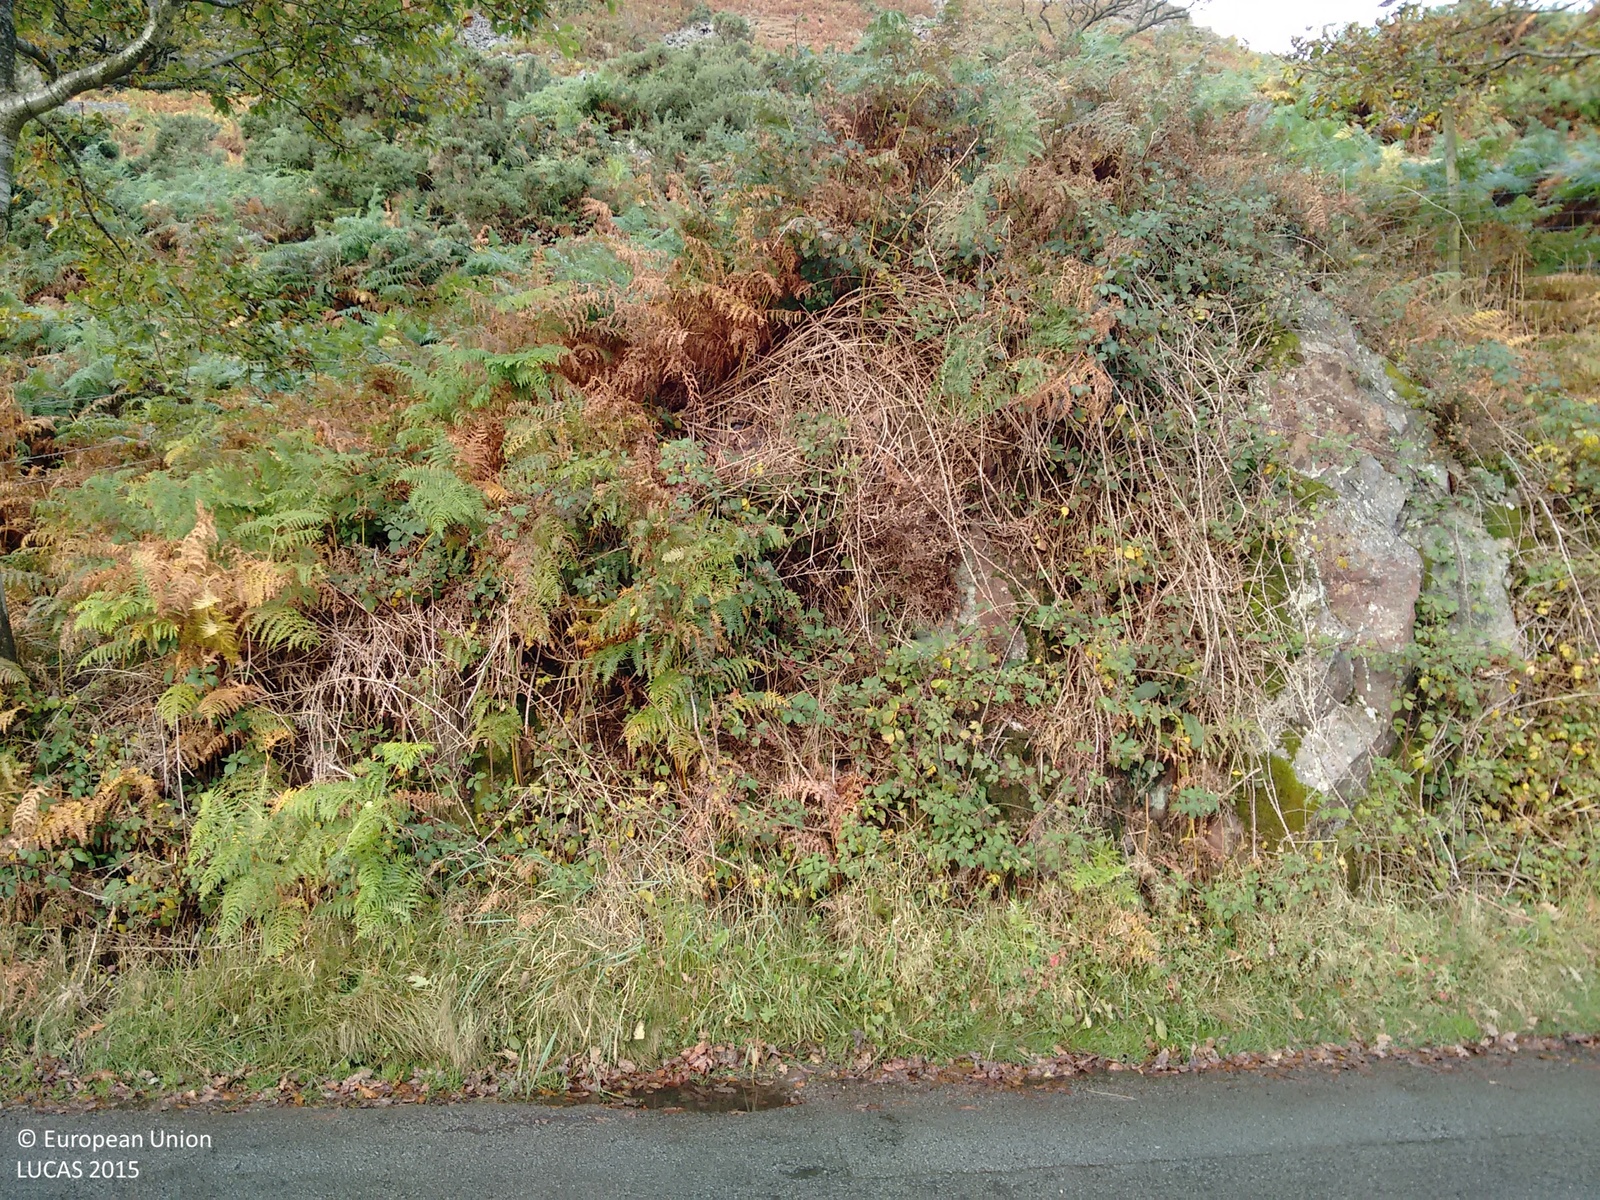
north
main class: Shrubland
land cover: Shrubland without tree cover
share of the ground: > 75 %
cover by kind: shrubs 100 %
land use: Agriculture (excluding fallow land and kitchen gardens)
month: October
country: GB
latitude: 54.3780
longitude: -3.3031
